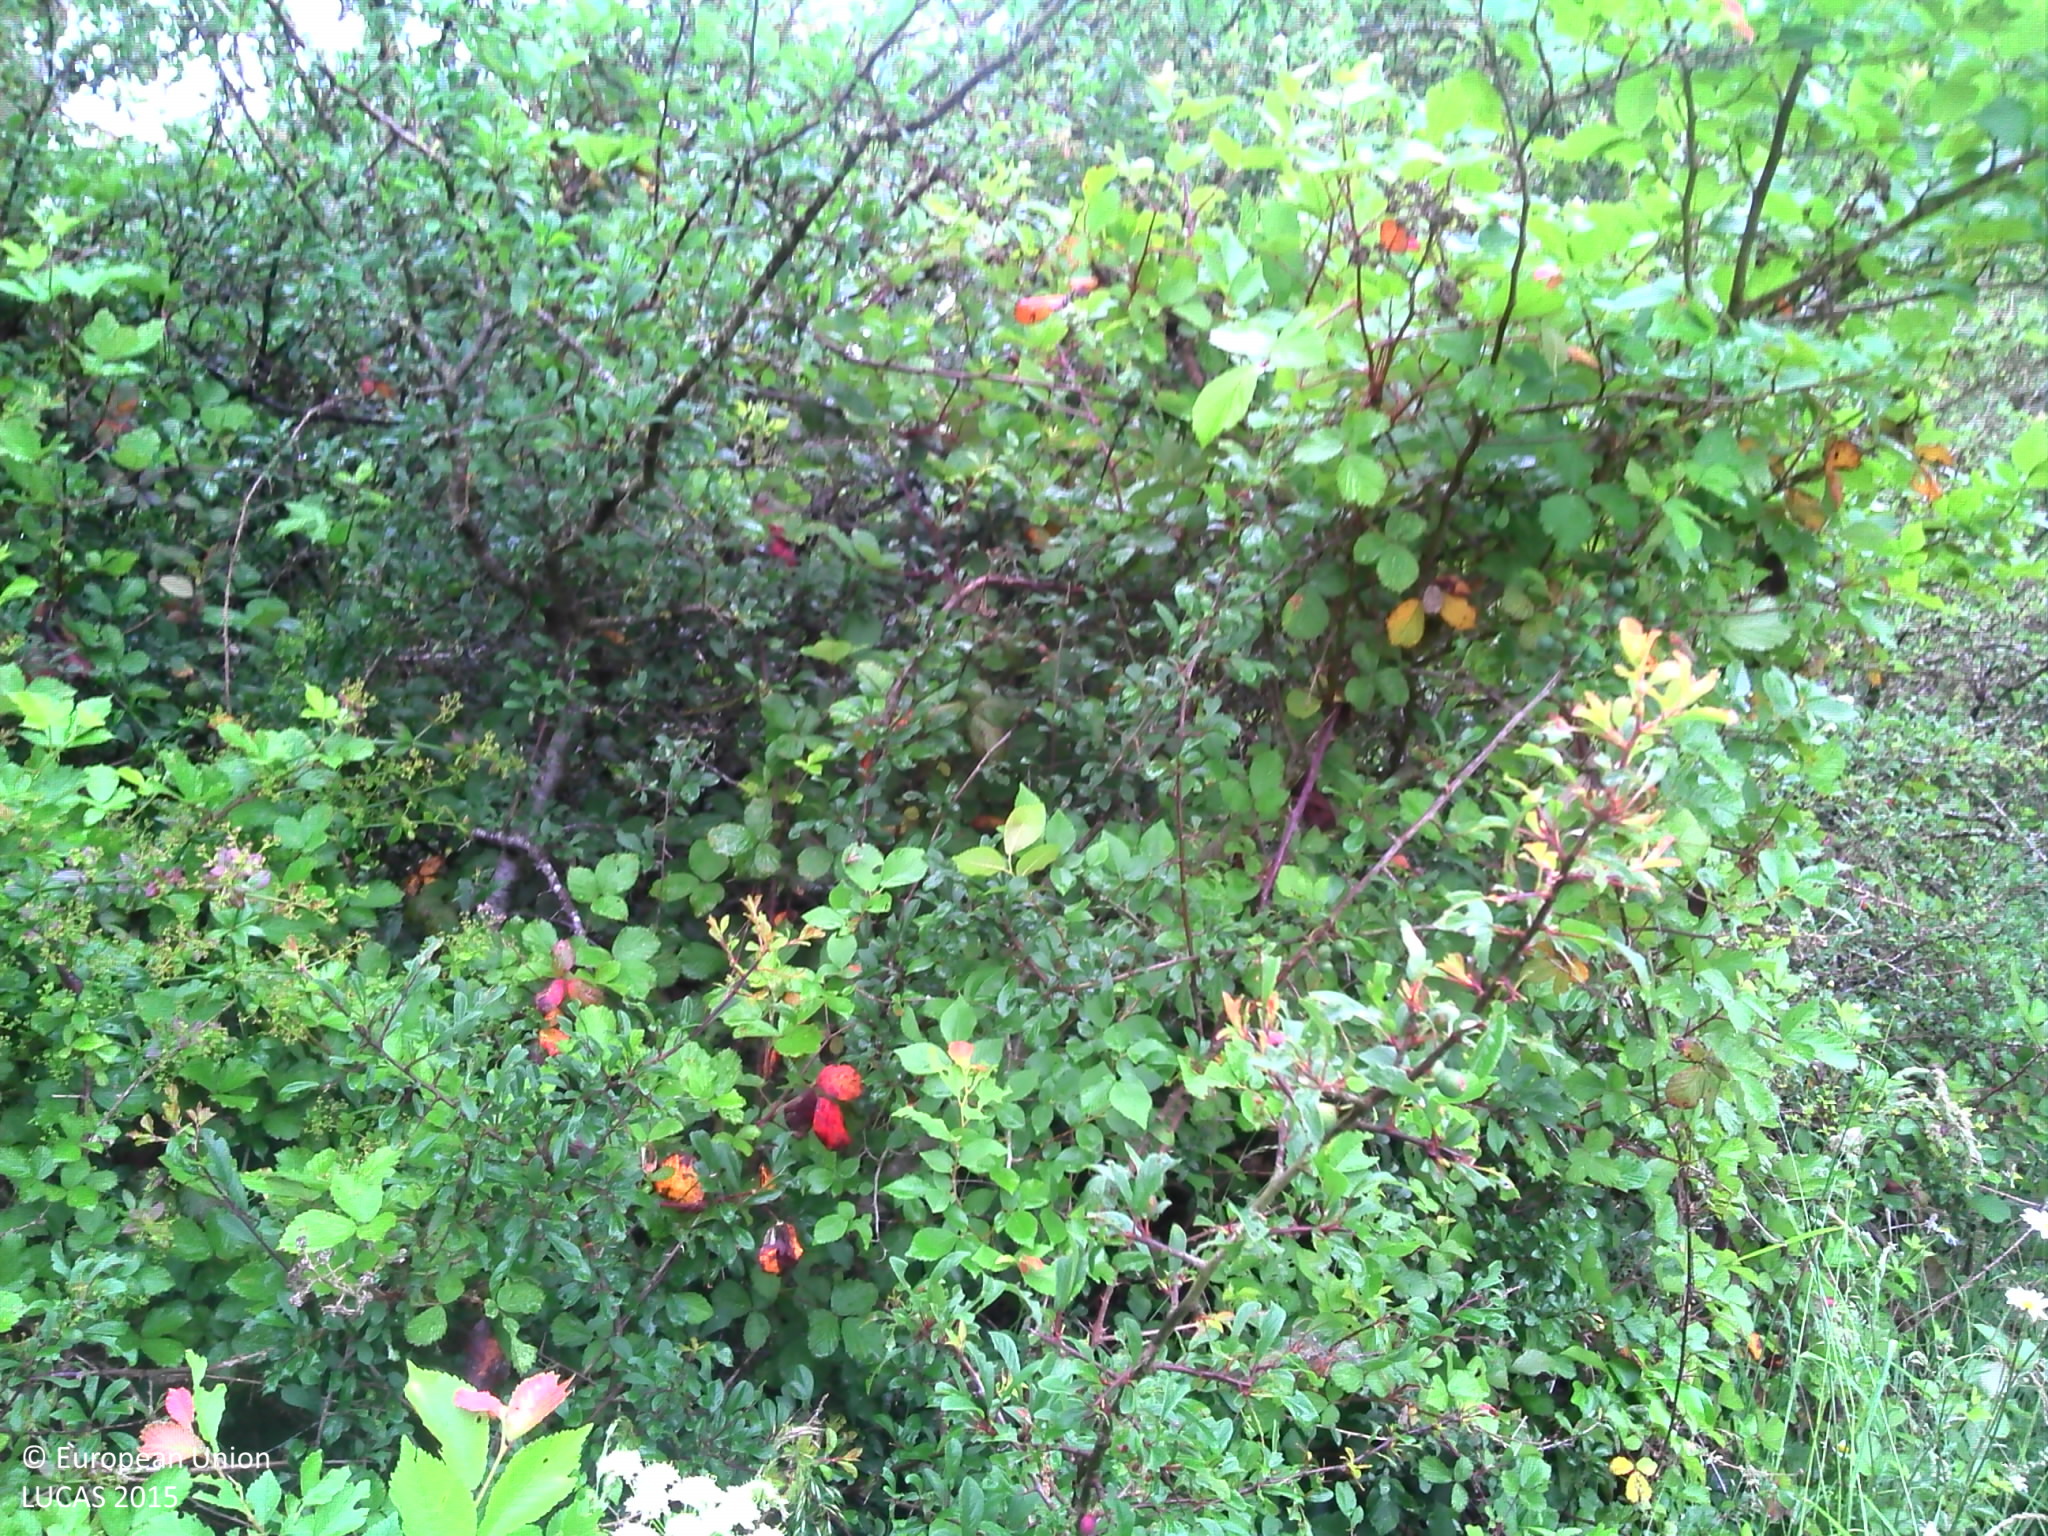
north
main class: Grassland
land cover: Grassland without tree/shrub cover
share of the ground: > 75 %
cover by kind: herbaceous plants 100 %
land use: Agriculture (excluding fallow land and kitchen gardens)
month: June
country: FR
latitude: 47.1716
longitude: -1.2658
